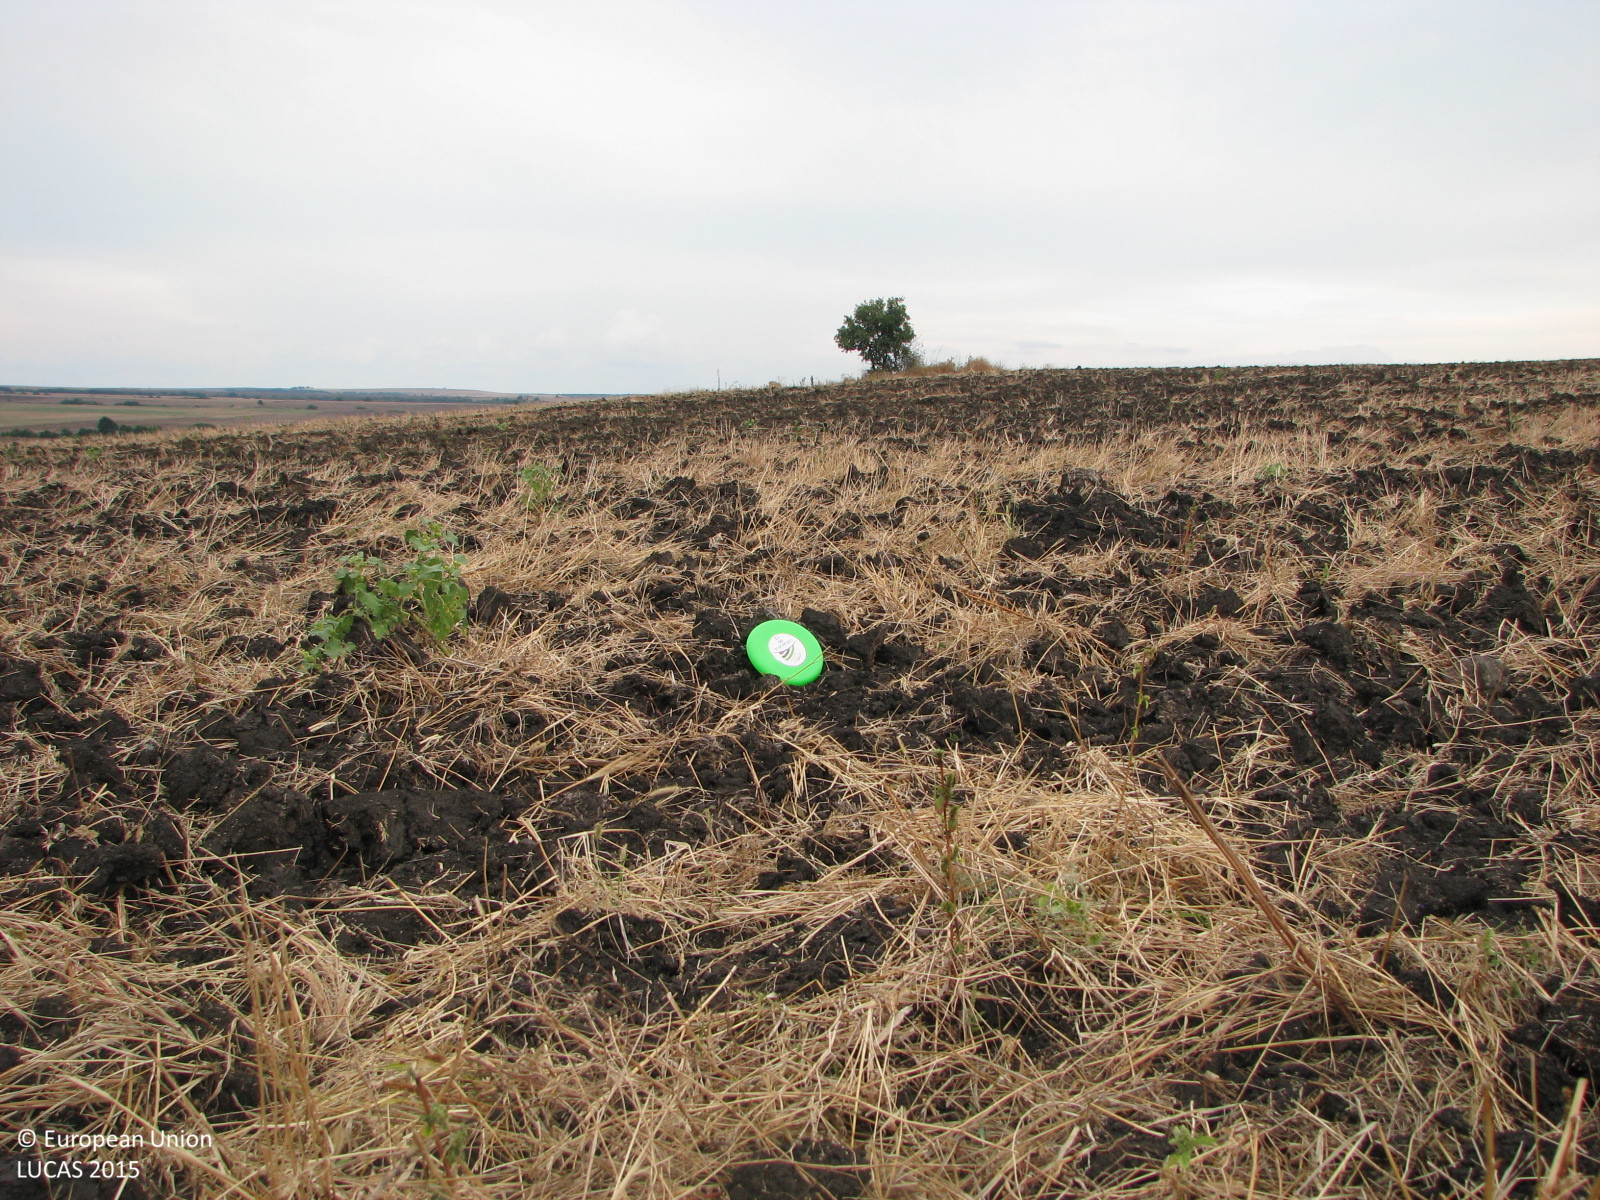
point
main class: Cropland
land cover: Common wheat
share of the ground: < 10 %
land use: Agriculture (excluding fallow land and kitchen gardens)
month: September
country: BG
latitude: 42.4346
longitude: 26.9131
